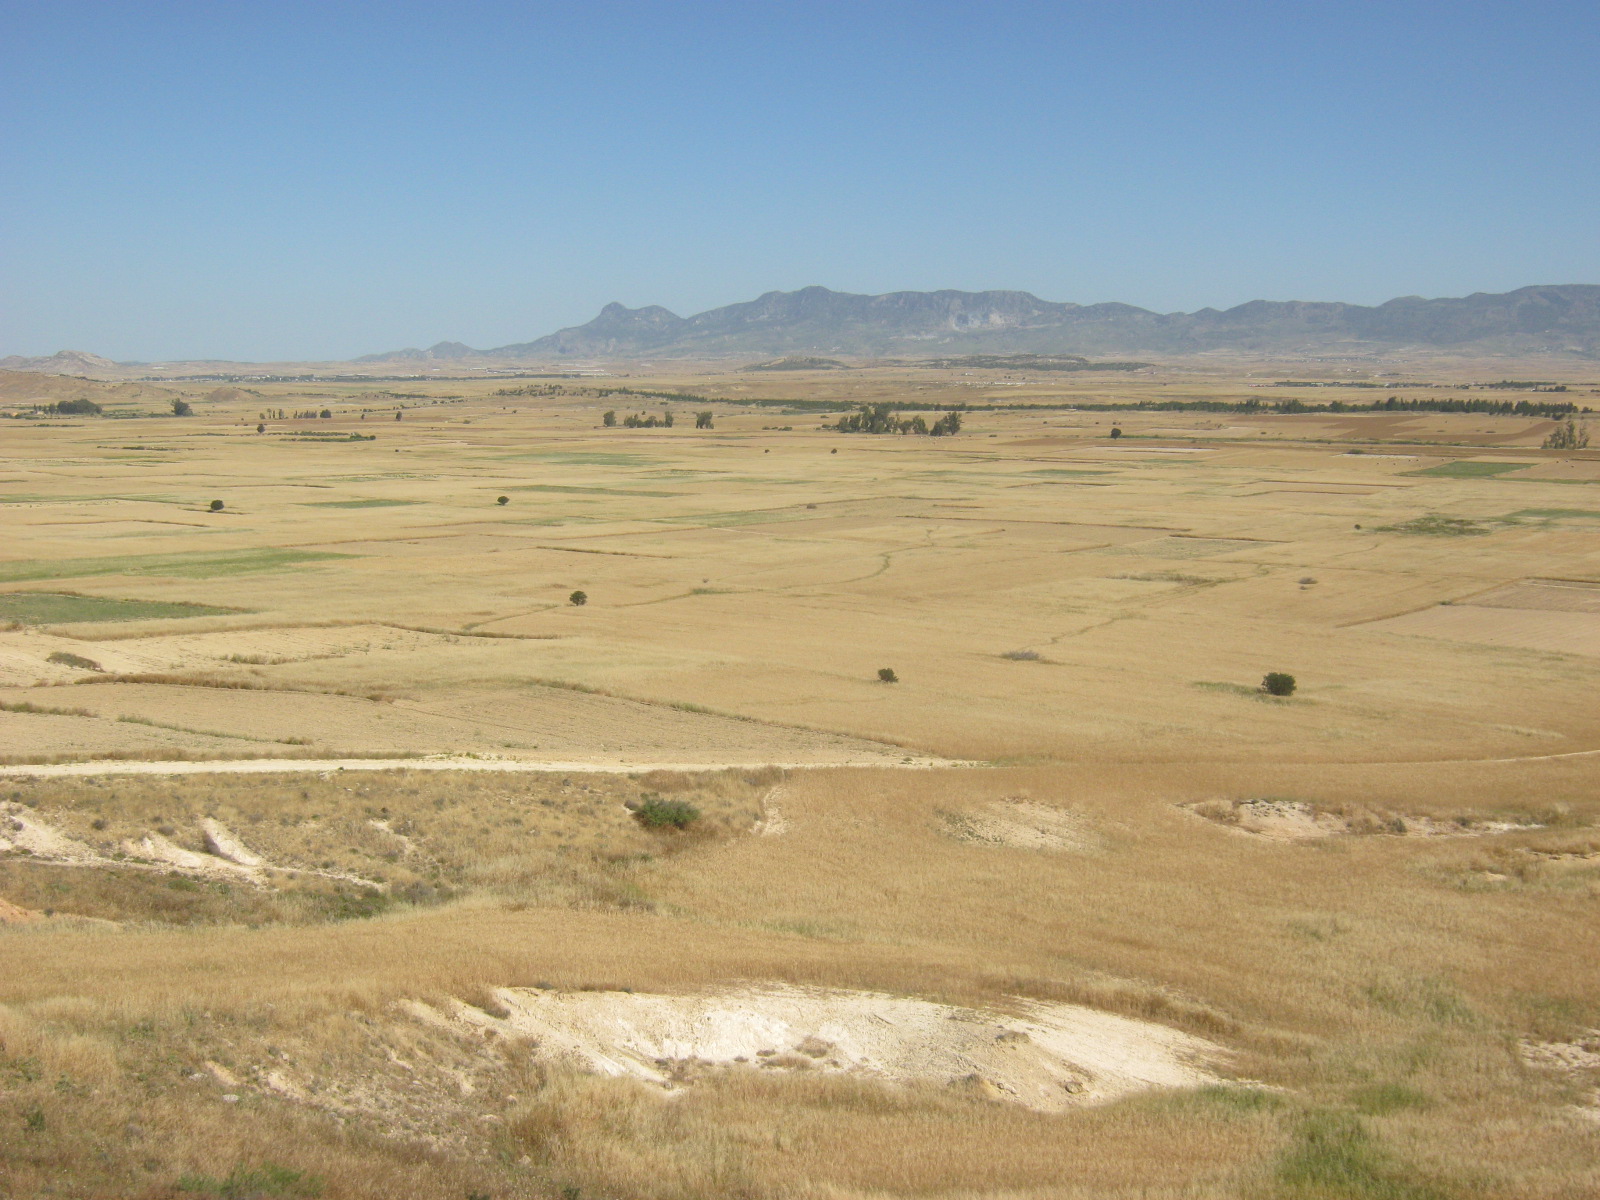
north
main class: Shrubland
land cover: Shrubland without tree cover
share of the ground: 25 - 50 %
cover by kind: unconsolidated bare surface 55 %, shrubs 40 %, herbaceous plants 5 %
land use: Semi-natural and natural areas not in use
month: May
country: CY
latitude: 35.1655
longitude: 33.2334
